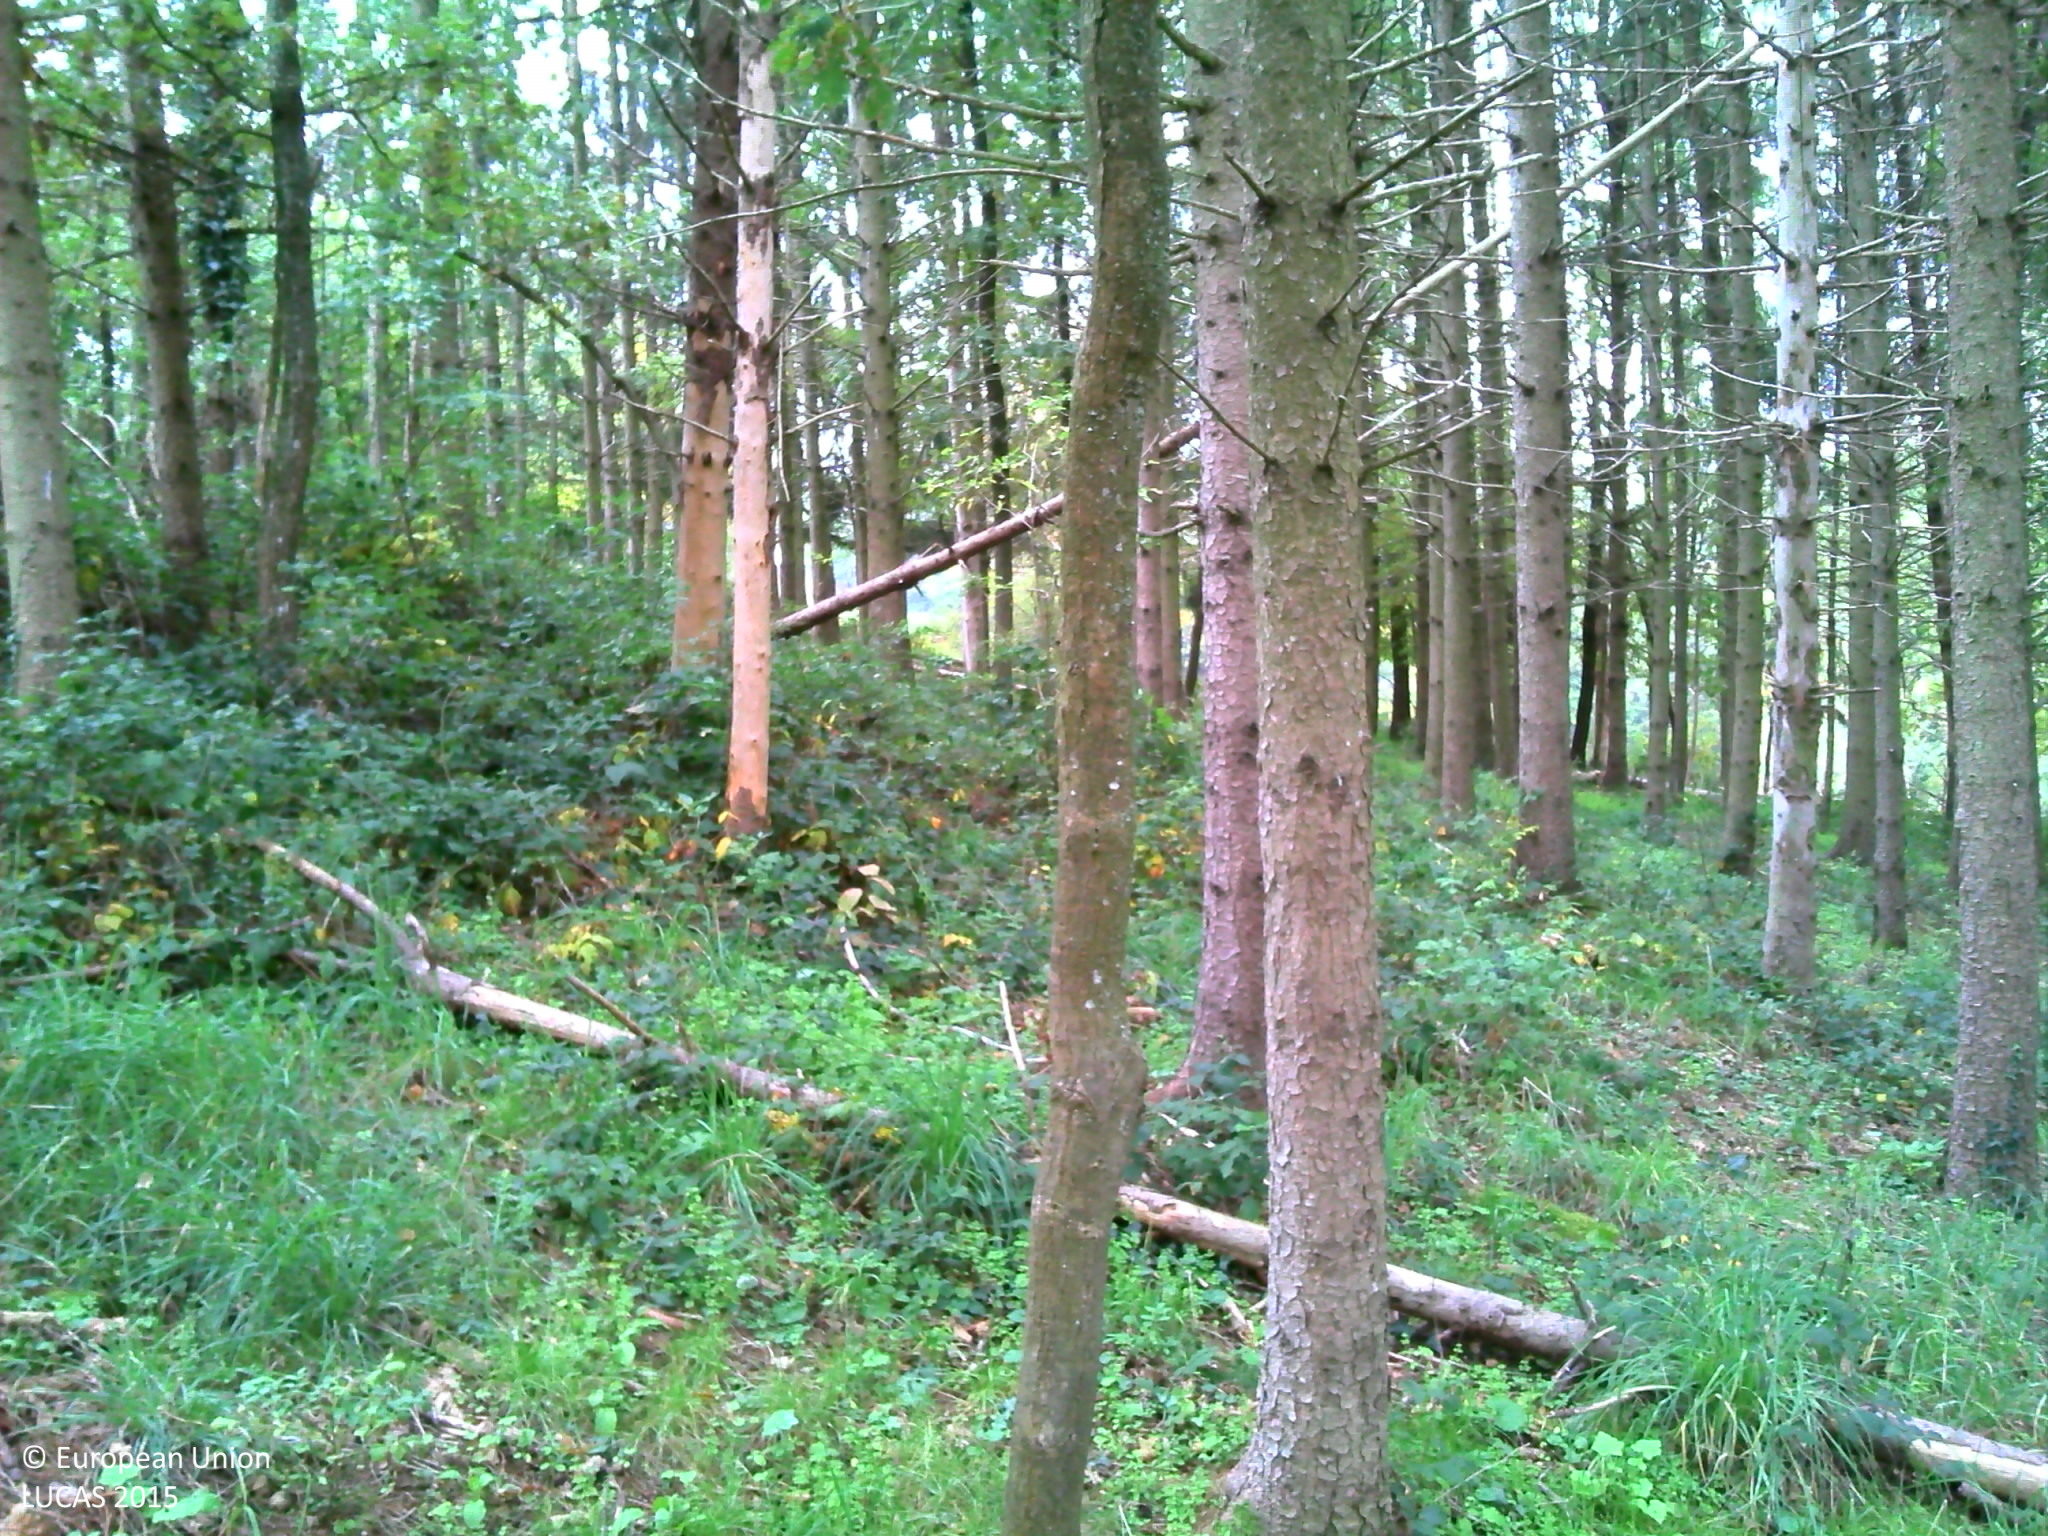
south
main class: Woodland
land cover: Spruce dominated coniferous woodland
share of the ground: > 75 %
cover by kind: coniferous forest trees 85 %, herbaceous plants 10 %, broadleaved forest trees 5 %
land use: Forestry
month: October
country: FR
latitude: 46.0140
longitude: 3.0113
